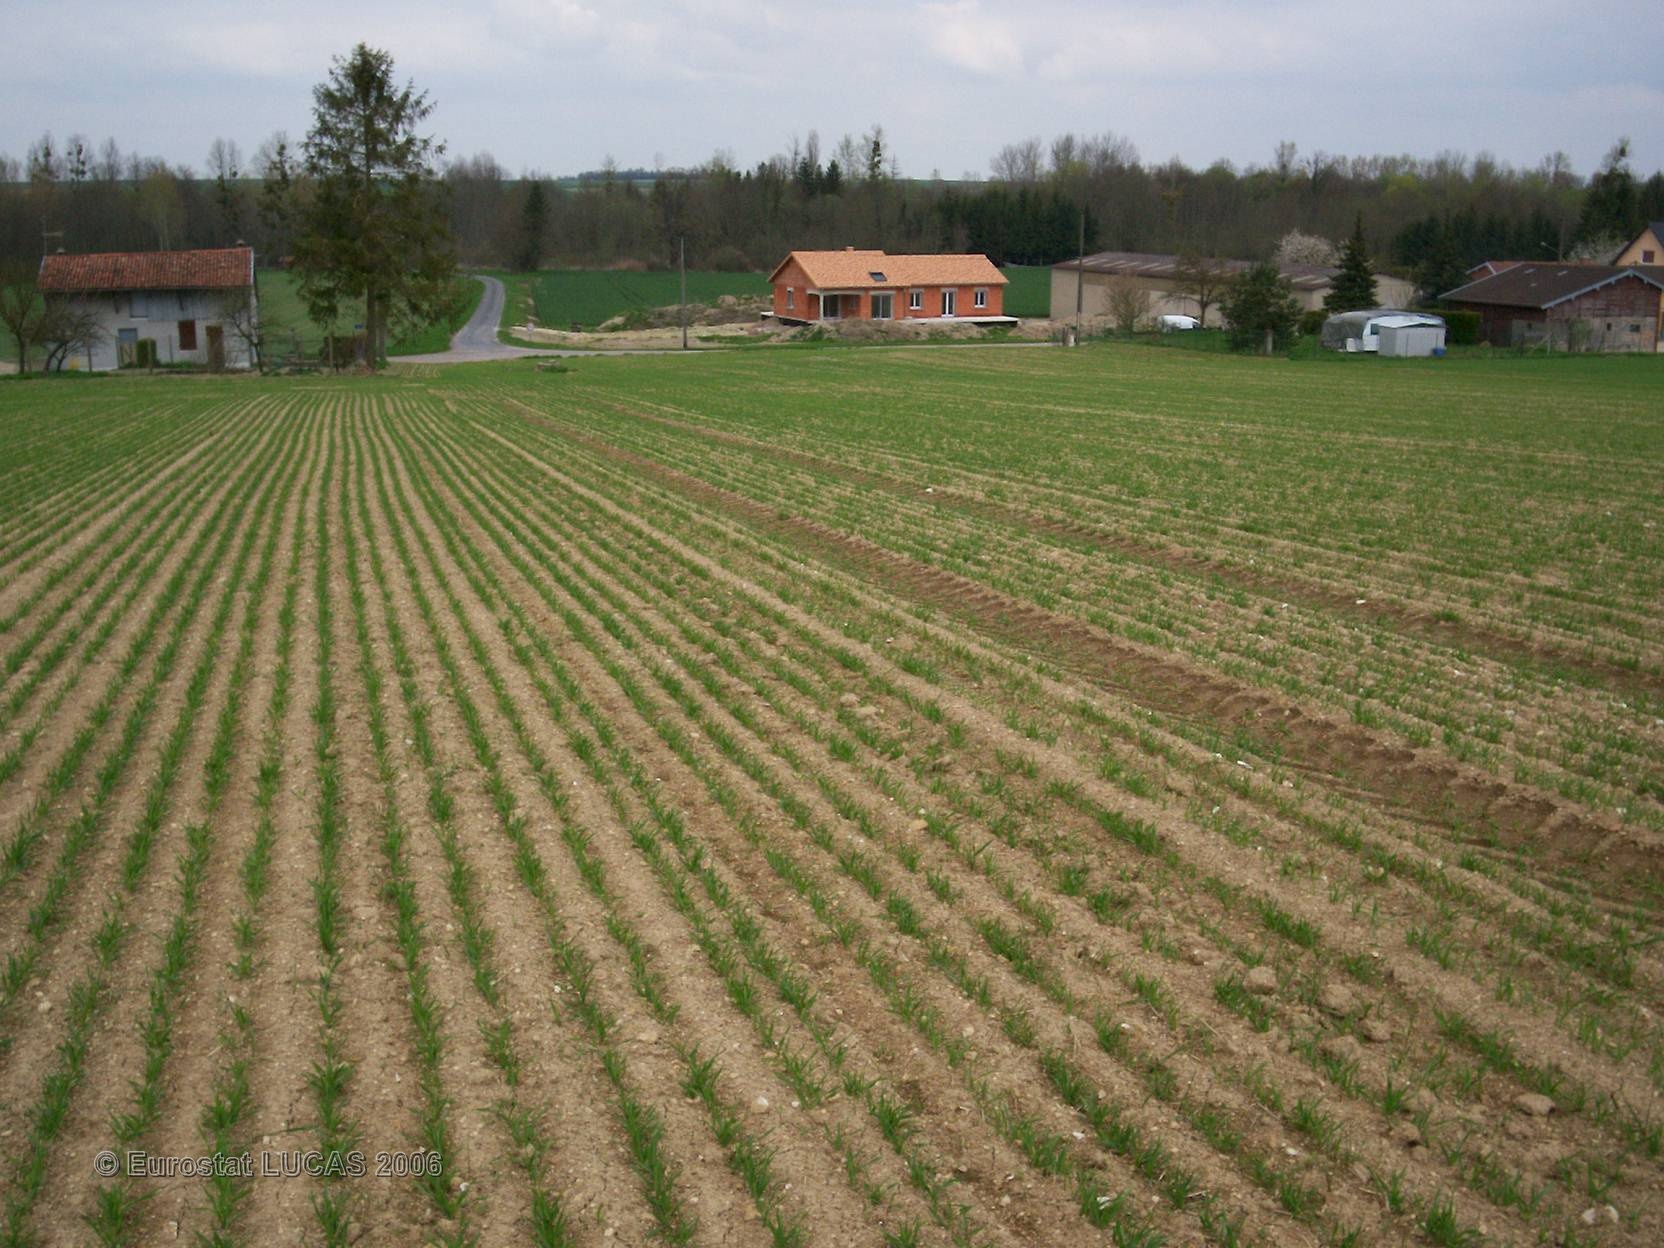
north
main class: Cropland
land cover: Barley
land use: Agriculture (excluding fallow land and kitchen gardens)
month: April
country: FR
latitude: 48.4813
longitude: 4.4639
